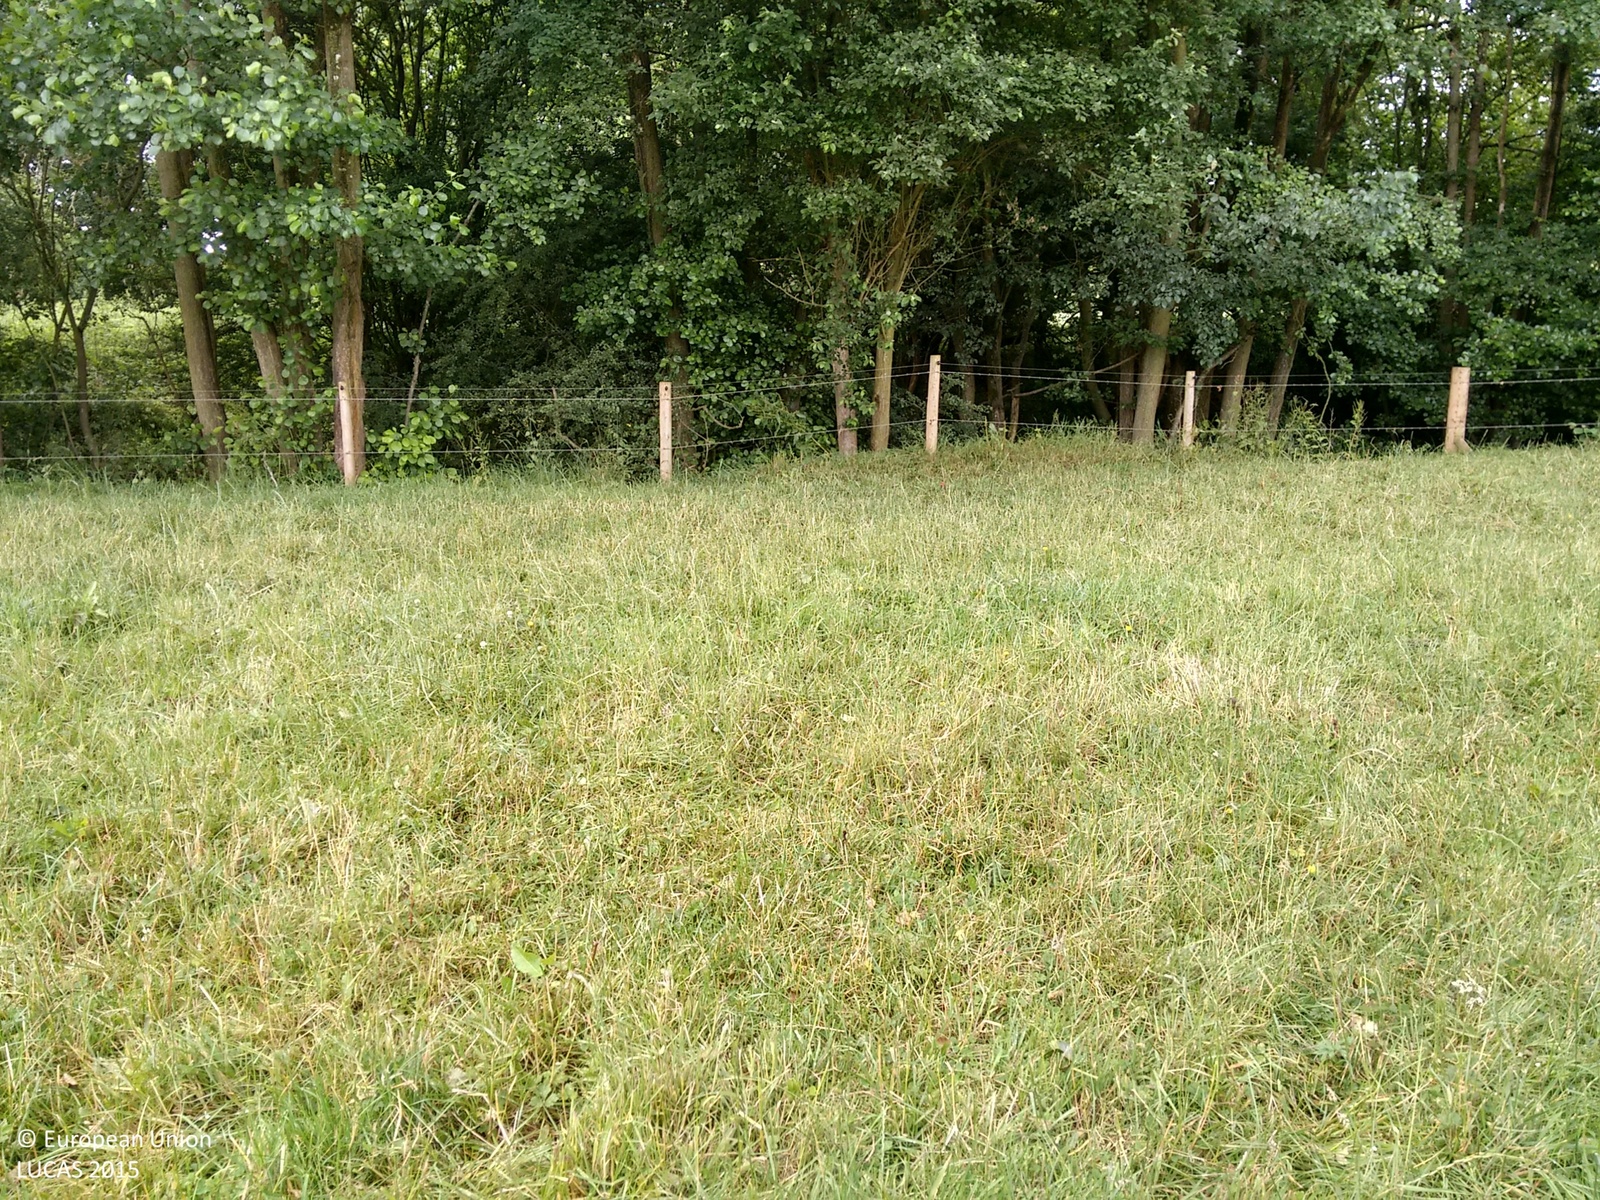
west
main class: Grassland
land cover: Grassland without tree/shrub cover
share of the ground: > 75 %
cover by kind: herbaceous plants 100 %
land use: Agriculture (excluding fallow land and kitchen gardens)
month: July
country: GB
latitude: 52.1438
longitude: -2.5614
